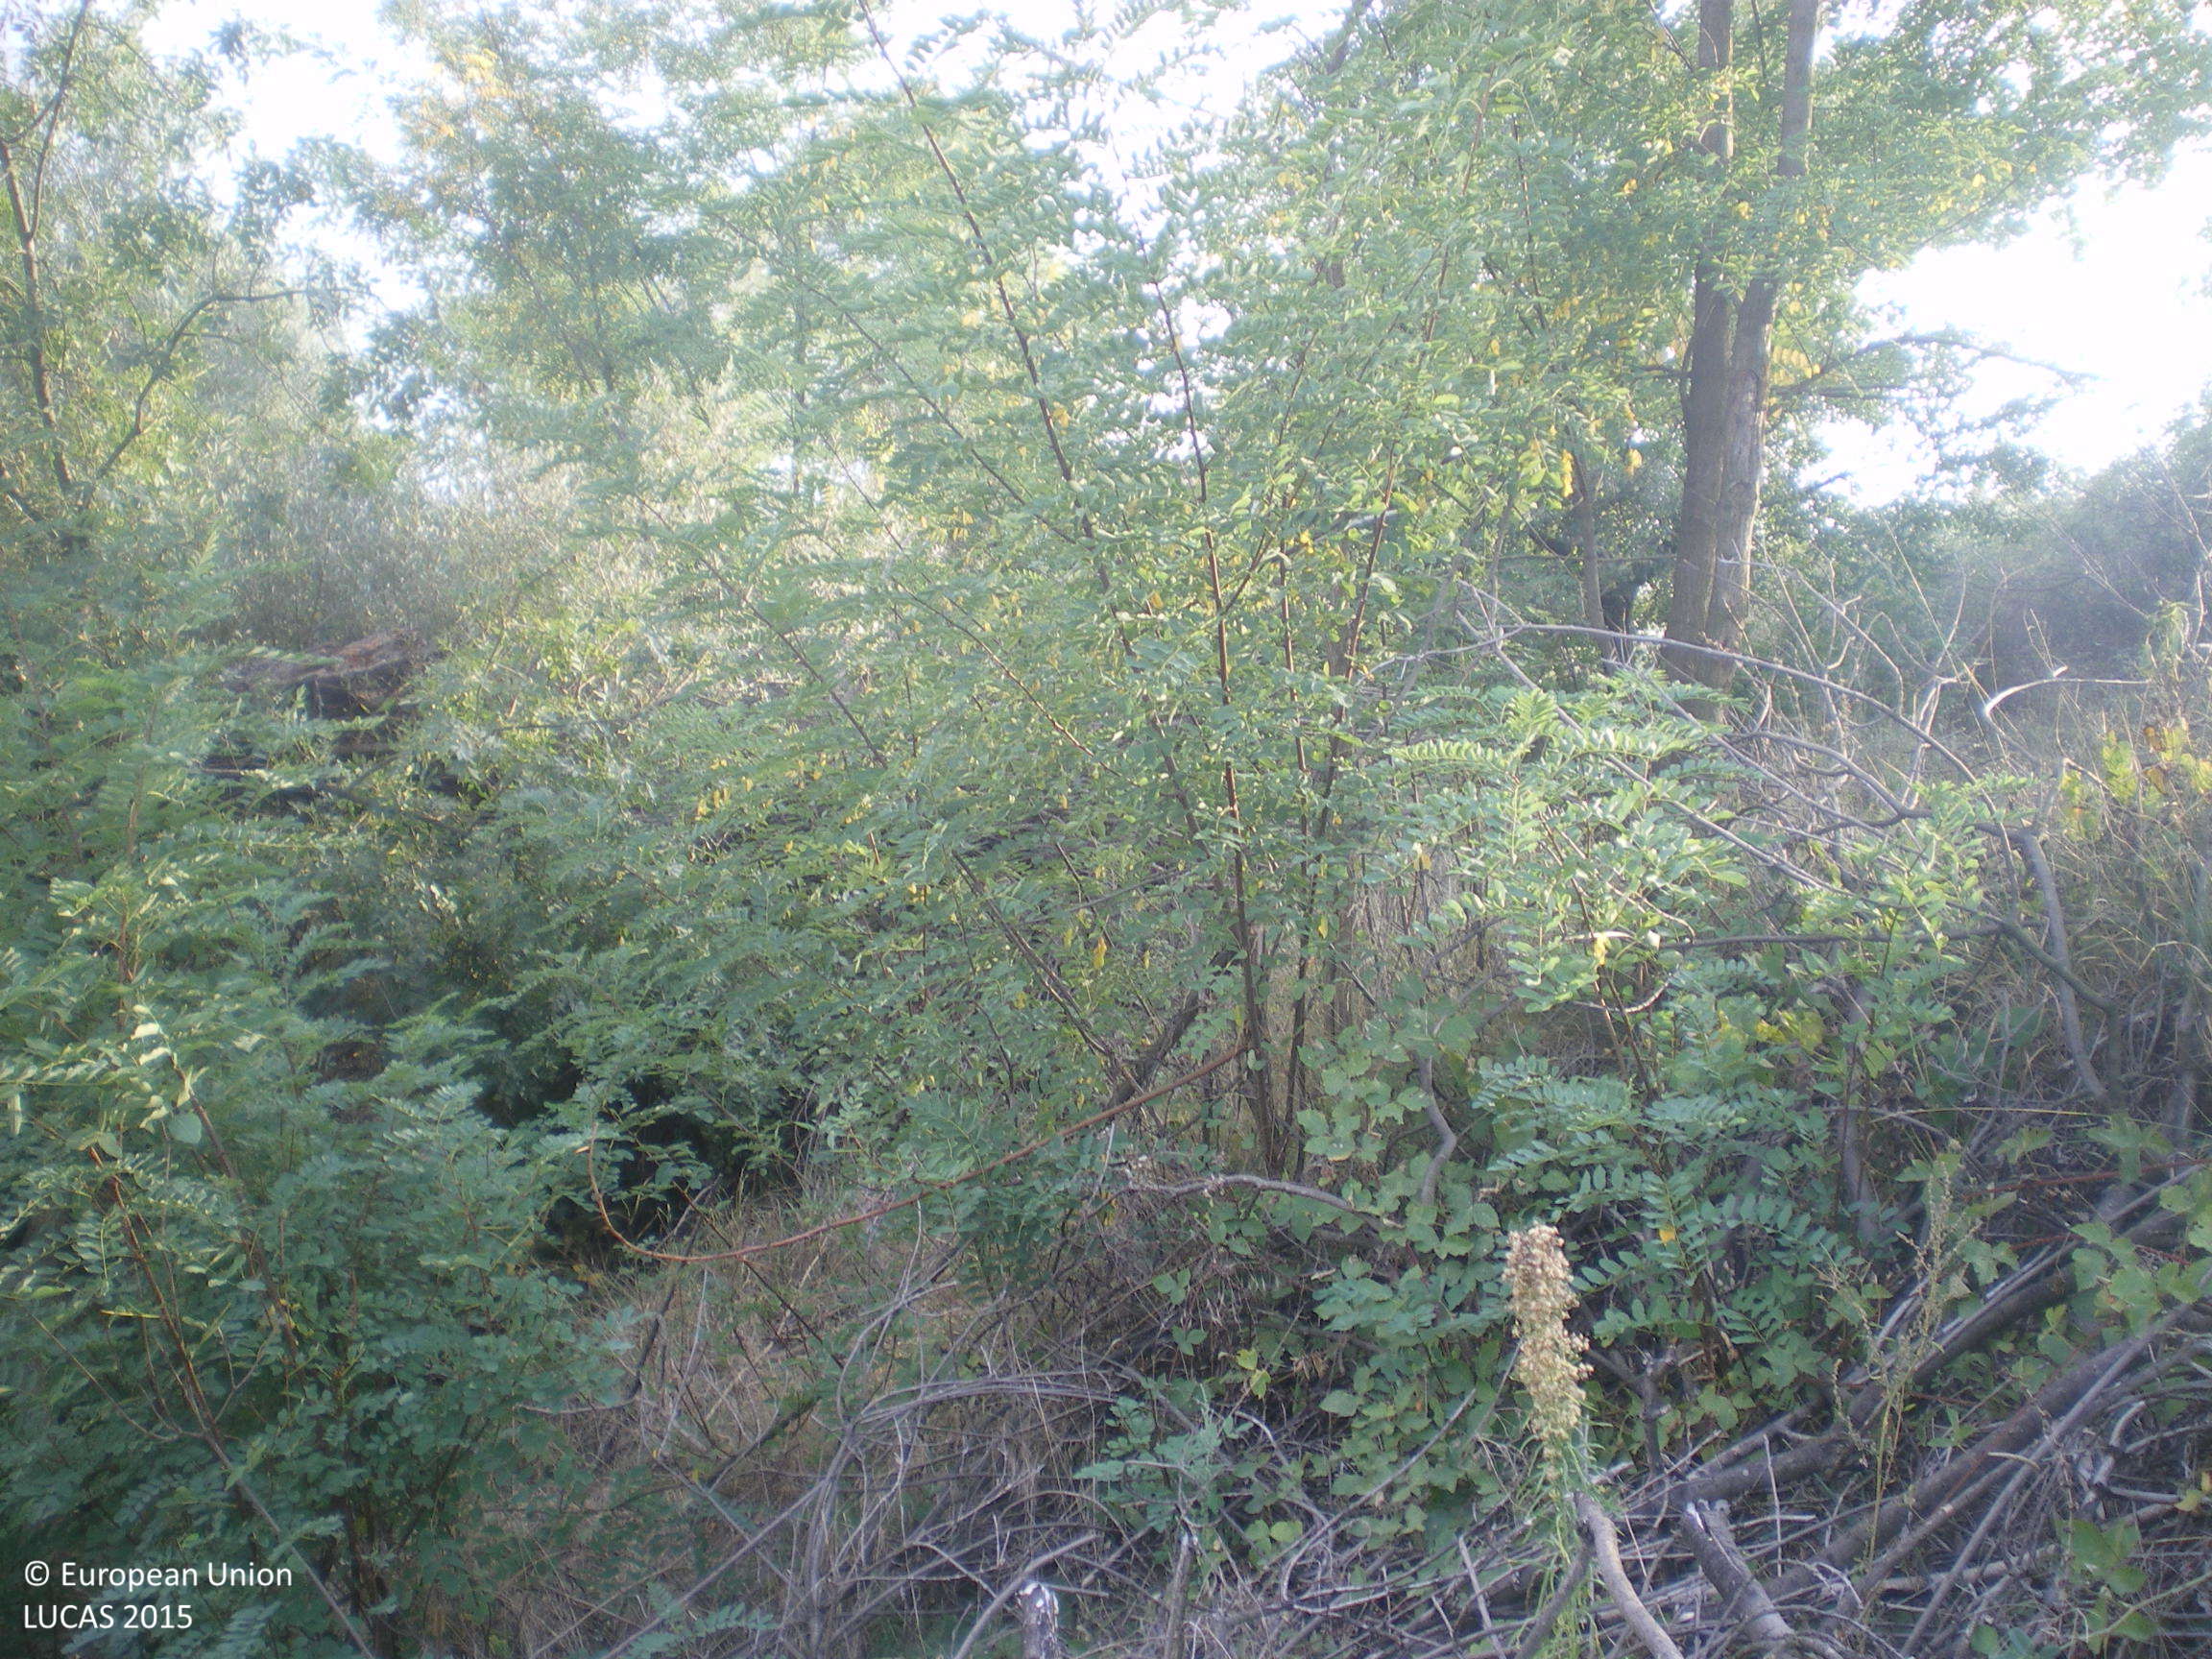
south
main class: Woodland
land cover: Broadleaved woodland
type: mesophytic deciduous forest
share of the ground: 50 - 75 %
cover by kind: broadleaved forest trees 50 %, herbaceous plants 45 %, shrubs 5 %
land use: Agriculture (excluding fallow land and kitchen gardens)
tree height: > 5 m
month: September
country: BG
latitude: 42.1094
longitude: 26.1020
